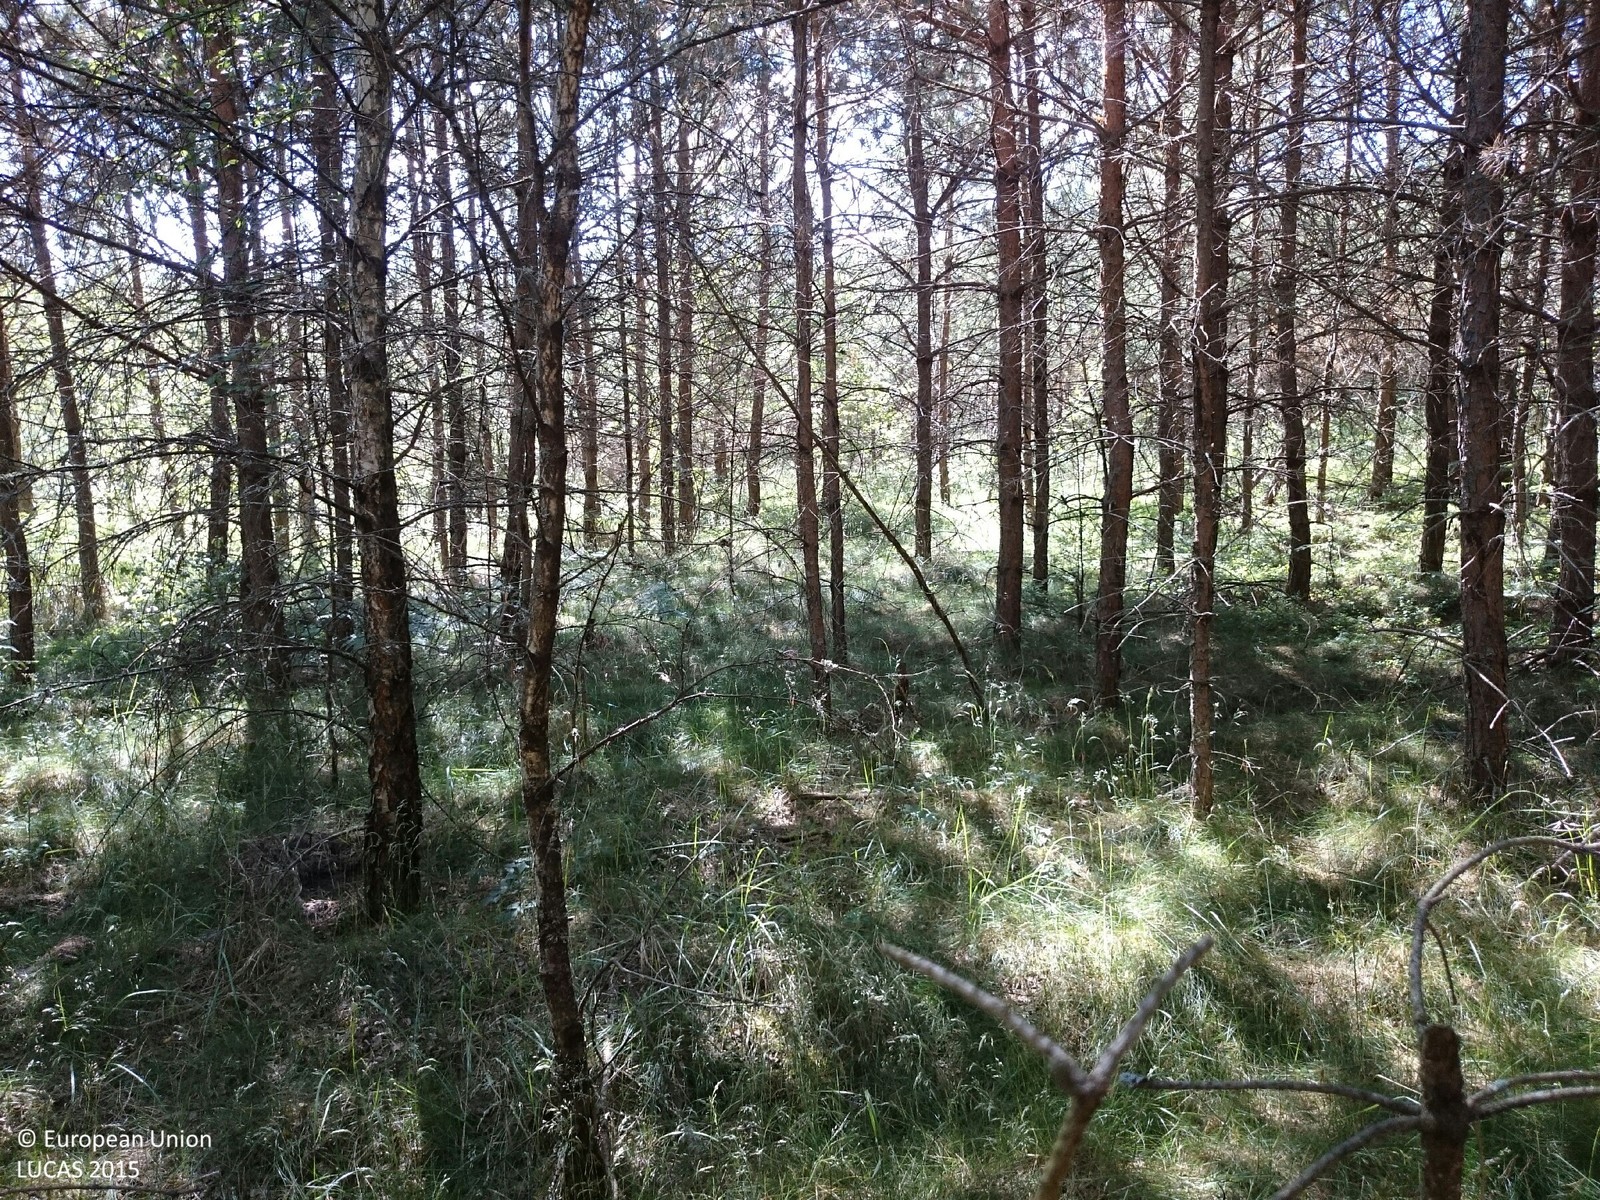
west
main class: Woodland
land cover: Pine dominated coniferous woodland
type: hemiboreal forest and nemoral coniferous forest and mixed broadleaved-coniferous forest
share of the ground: > 75 %
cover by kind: coniferous forest trees 90 %, herbaceous plants 5 %, lichens and mosses 5 %
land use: Forestry
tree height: > 5 m
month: June
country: PL
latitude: 52.9810
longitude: 16.0375
